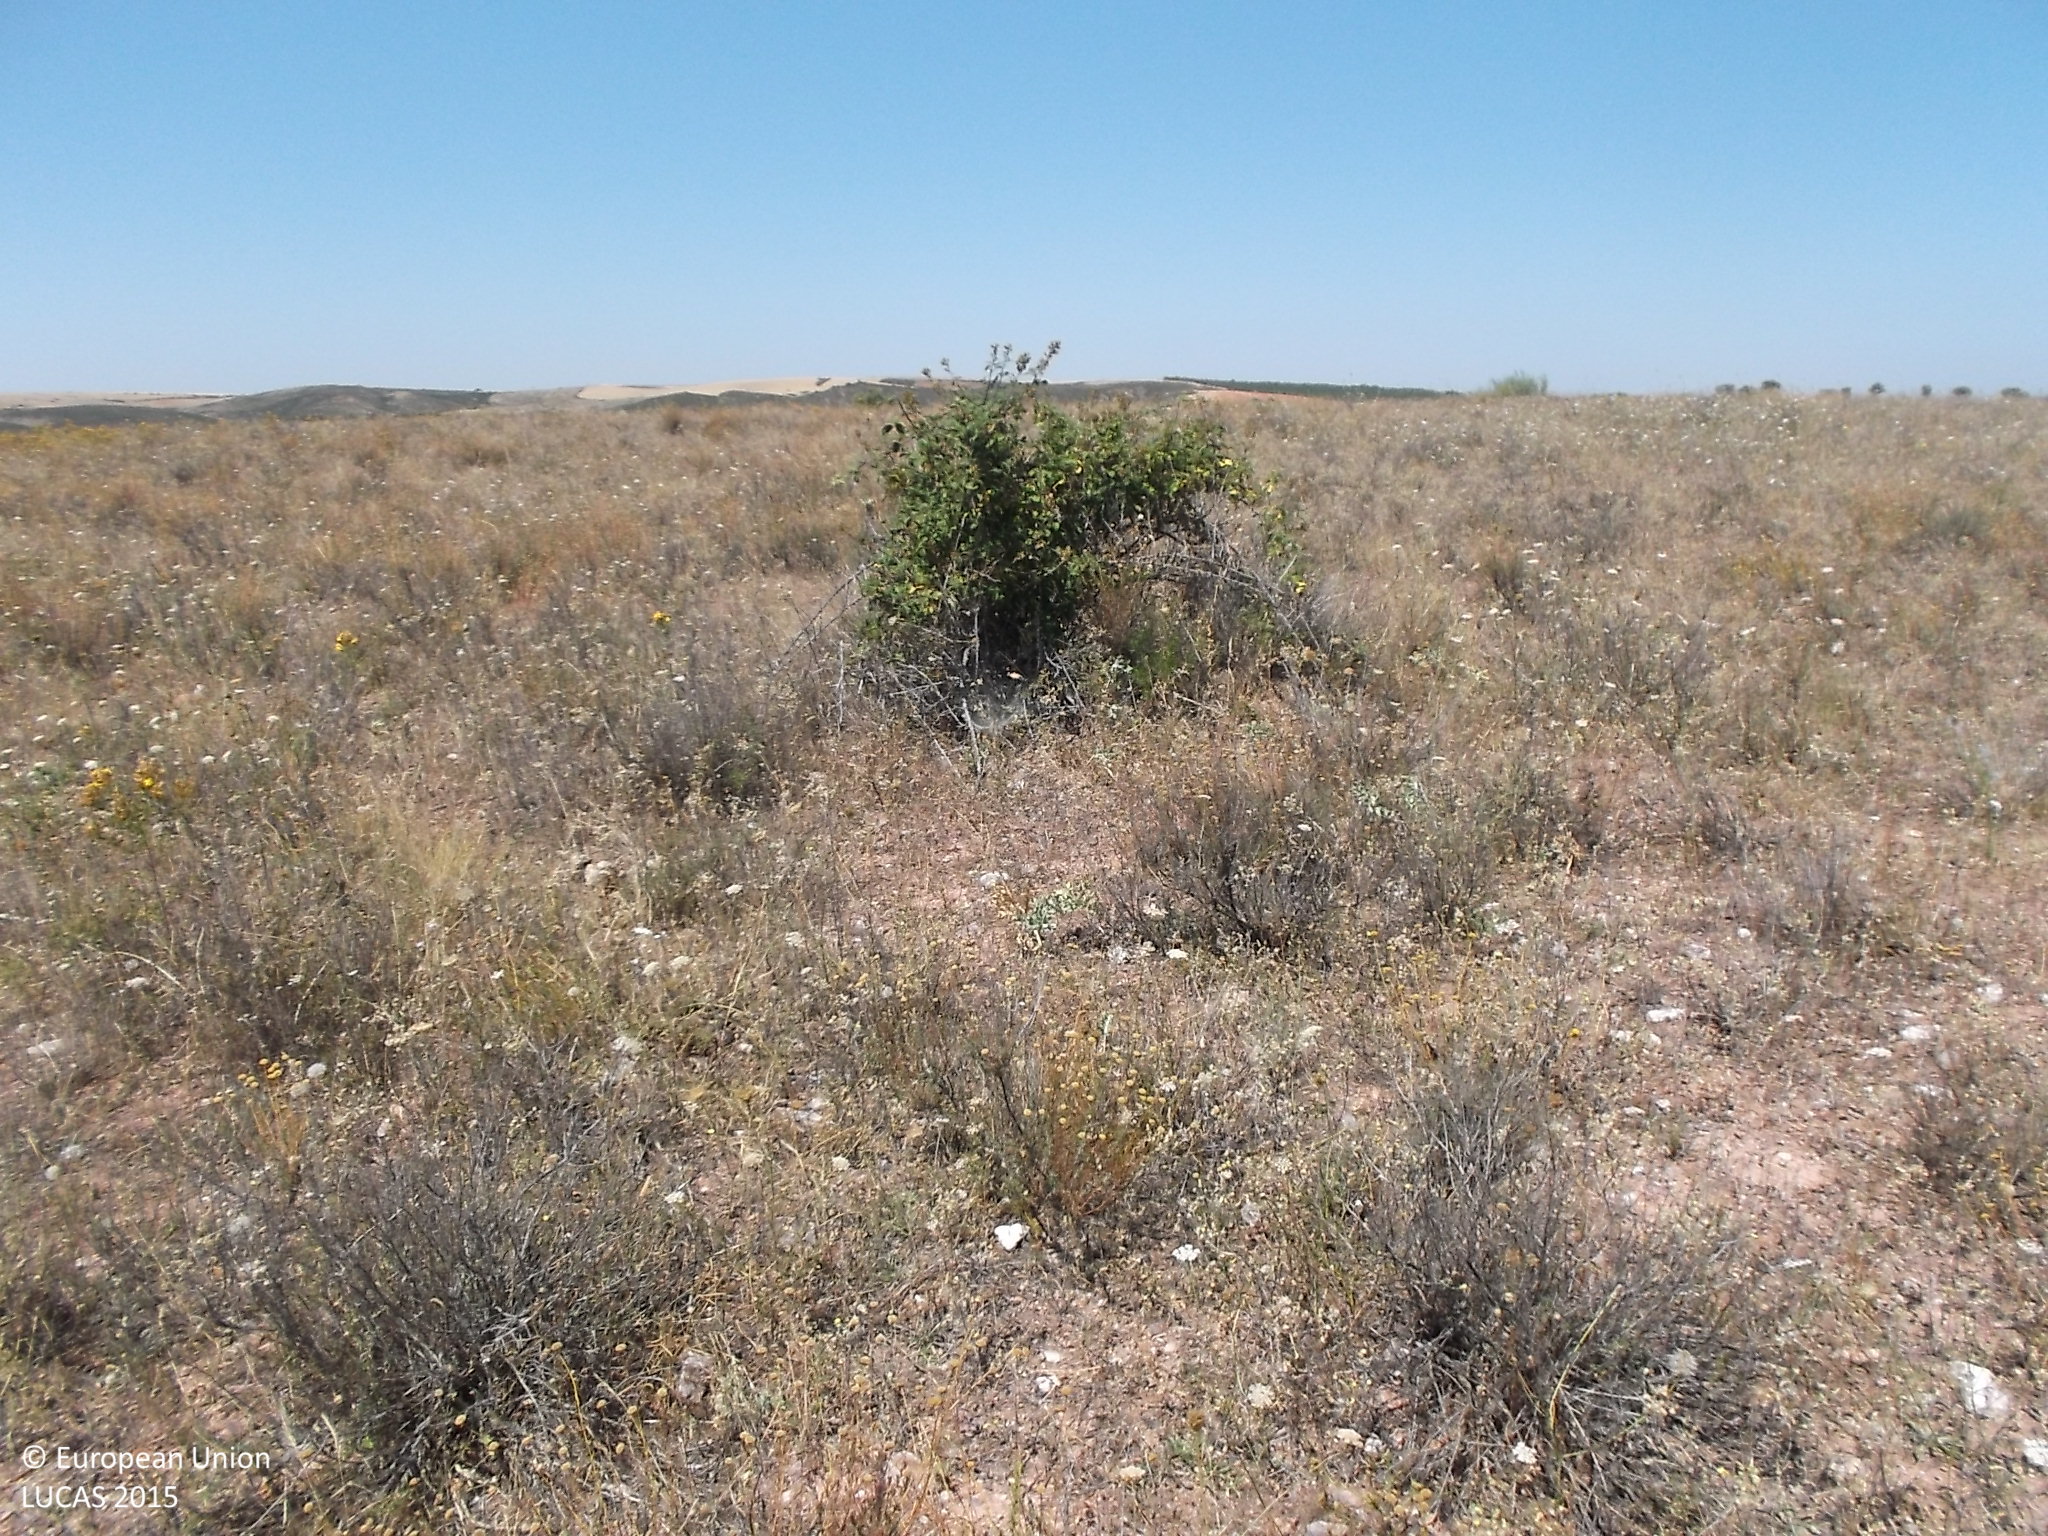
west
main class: Shrubland
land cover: Shrubland without tree cover
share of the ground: > 75 %
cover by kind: shrubs 100 %
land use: Agriculture (excluding fallow land and kitchen gardens)
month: July
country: ES
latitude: 41.4551
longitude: -5.8297
